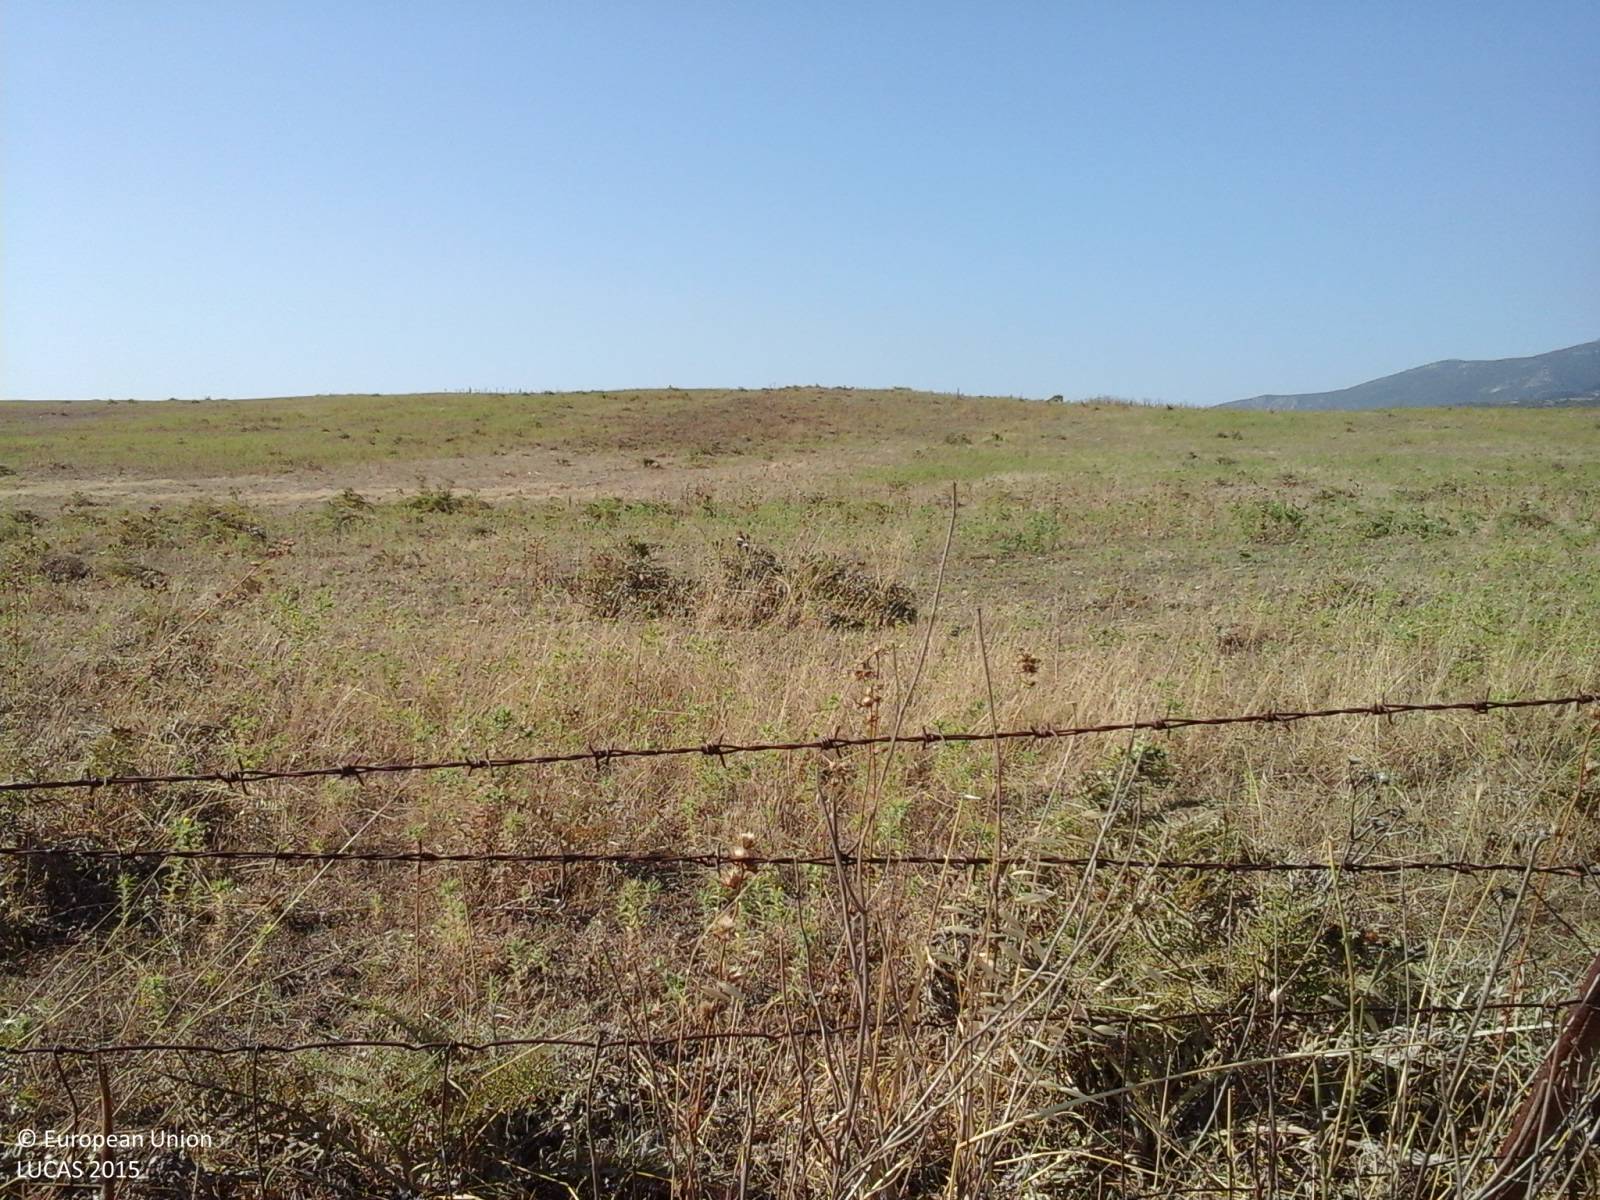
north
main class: Grassland
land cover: Grassland without tree/shrub cover
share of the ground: > 75 %
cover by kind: herbaceous plants 100 %
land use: Agriculture (excluding fallow land and kitchen gardens)
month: June
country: IT
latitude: 39.8976
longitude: 8.7787
